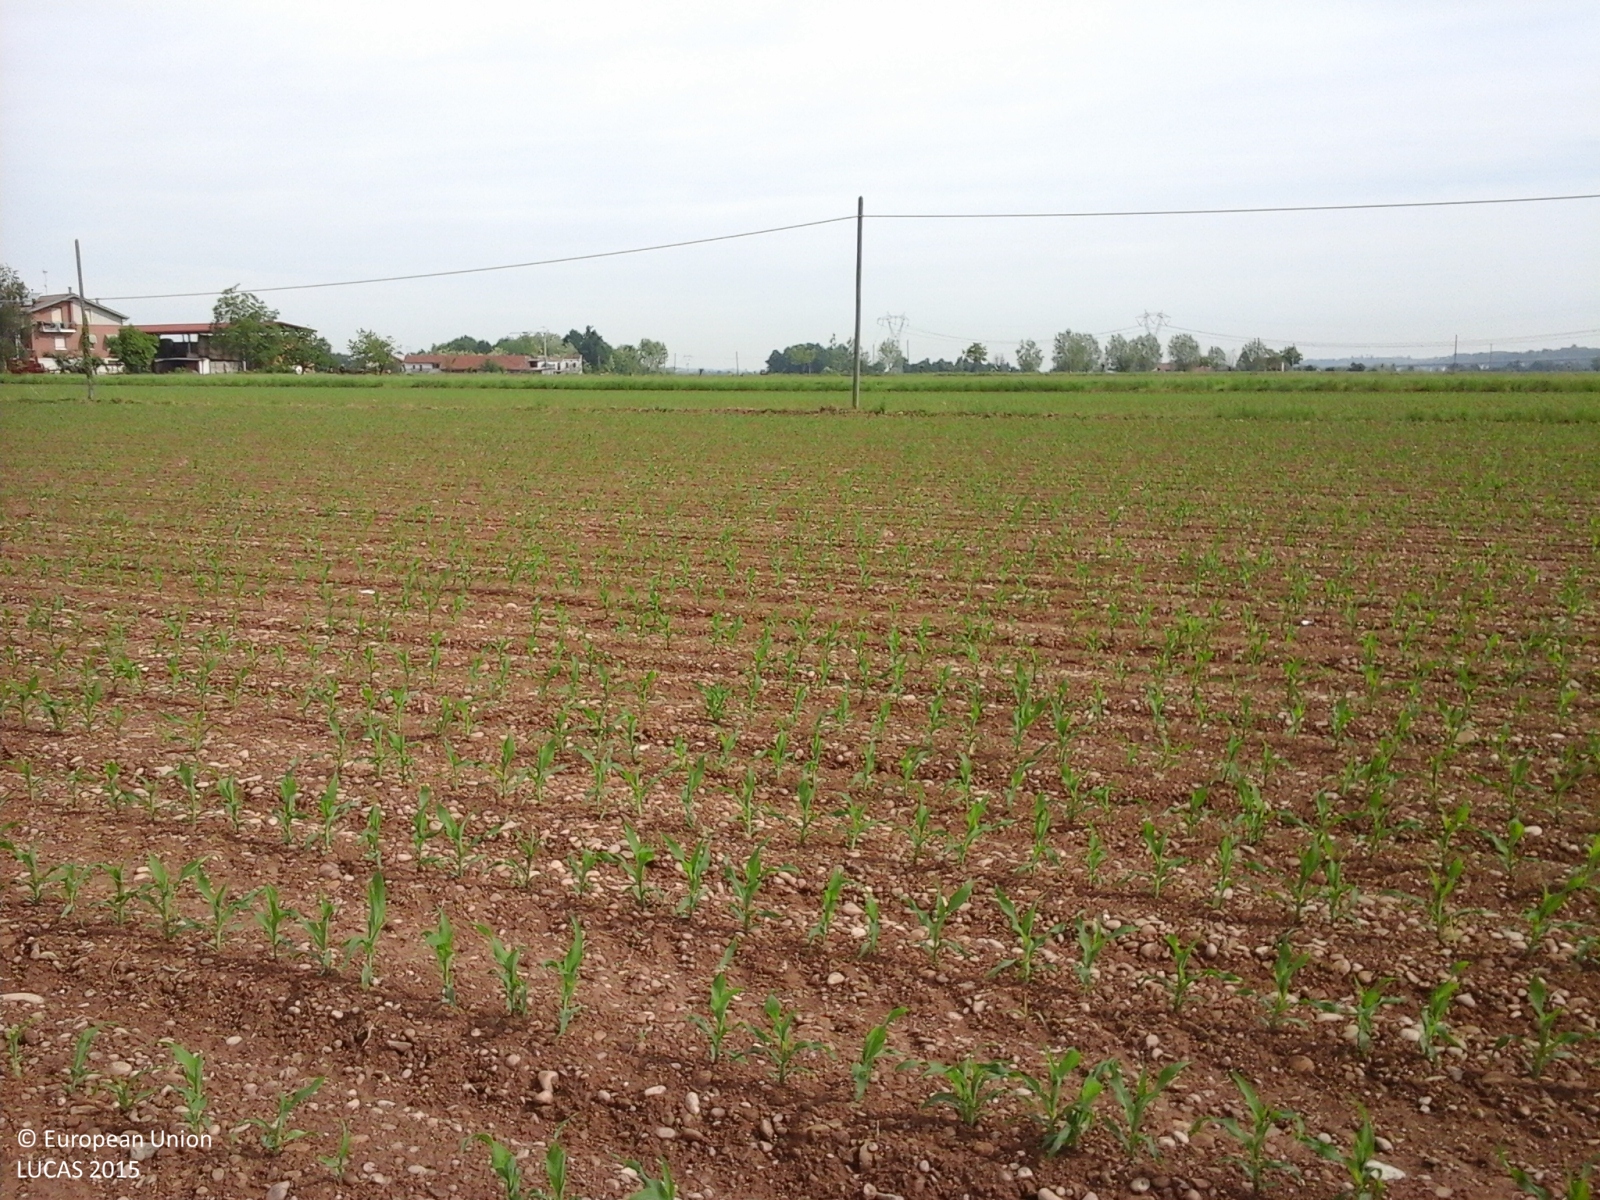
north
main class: Cropland
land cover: Maize
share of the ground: 25 - 50 %
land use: Agriculture (excluding fallow land and kitchen gardens)
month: May
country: IT
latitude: 44.5427
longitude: 7.7517
